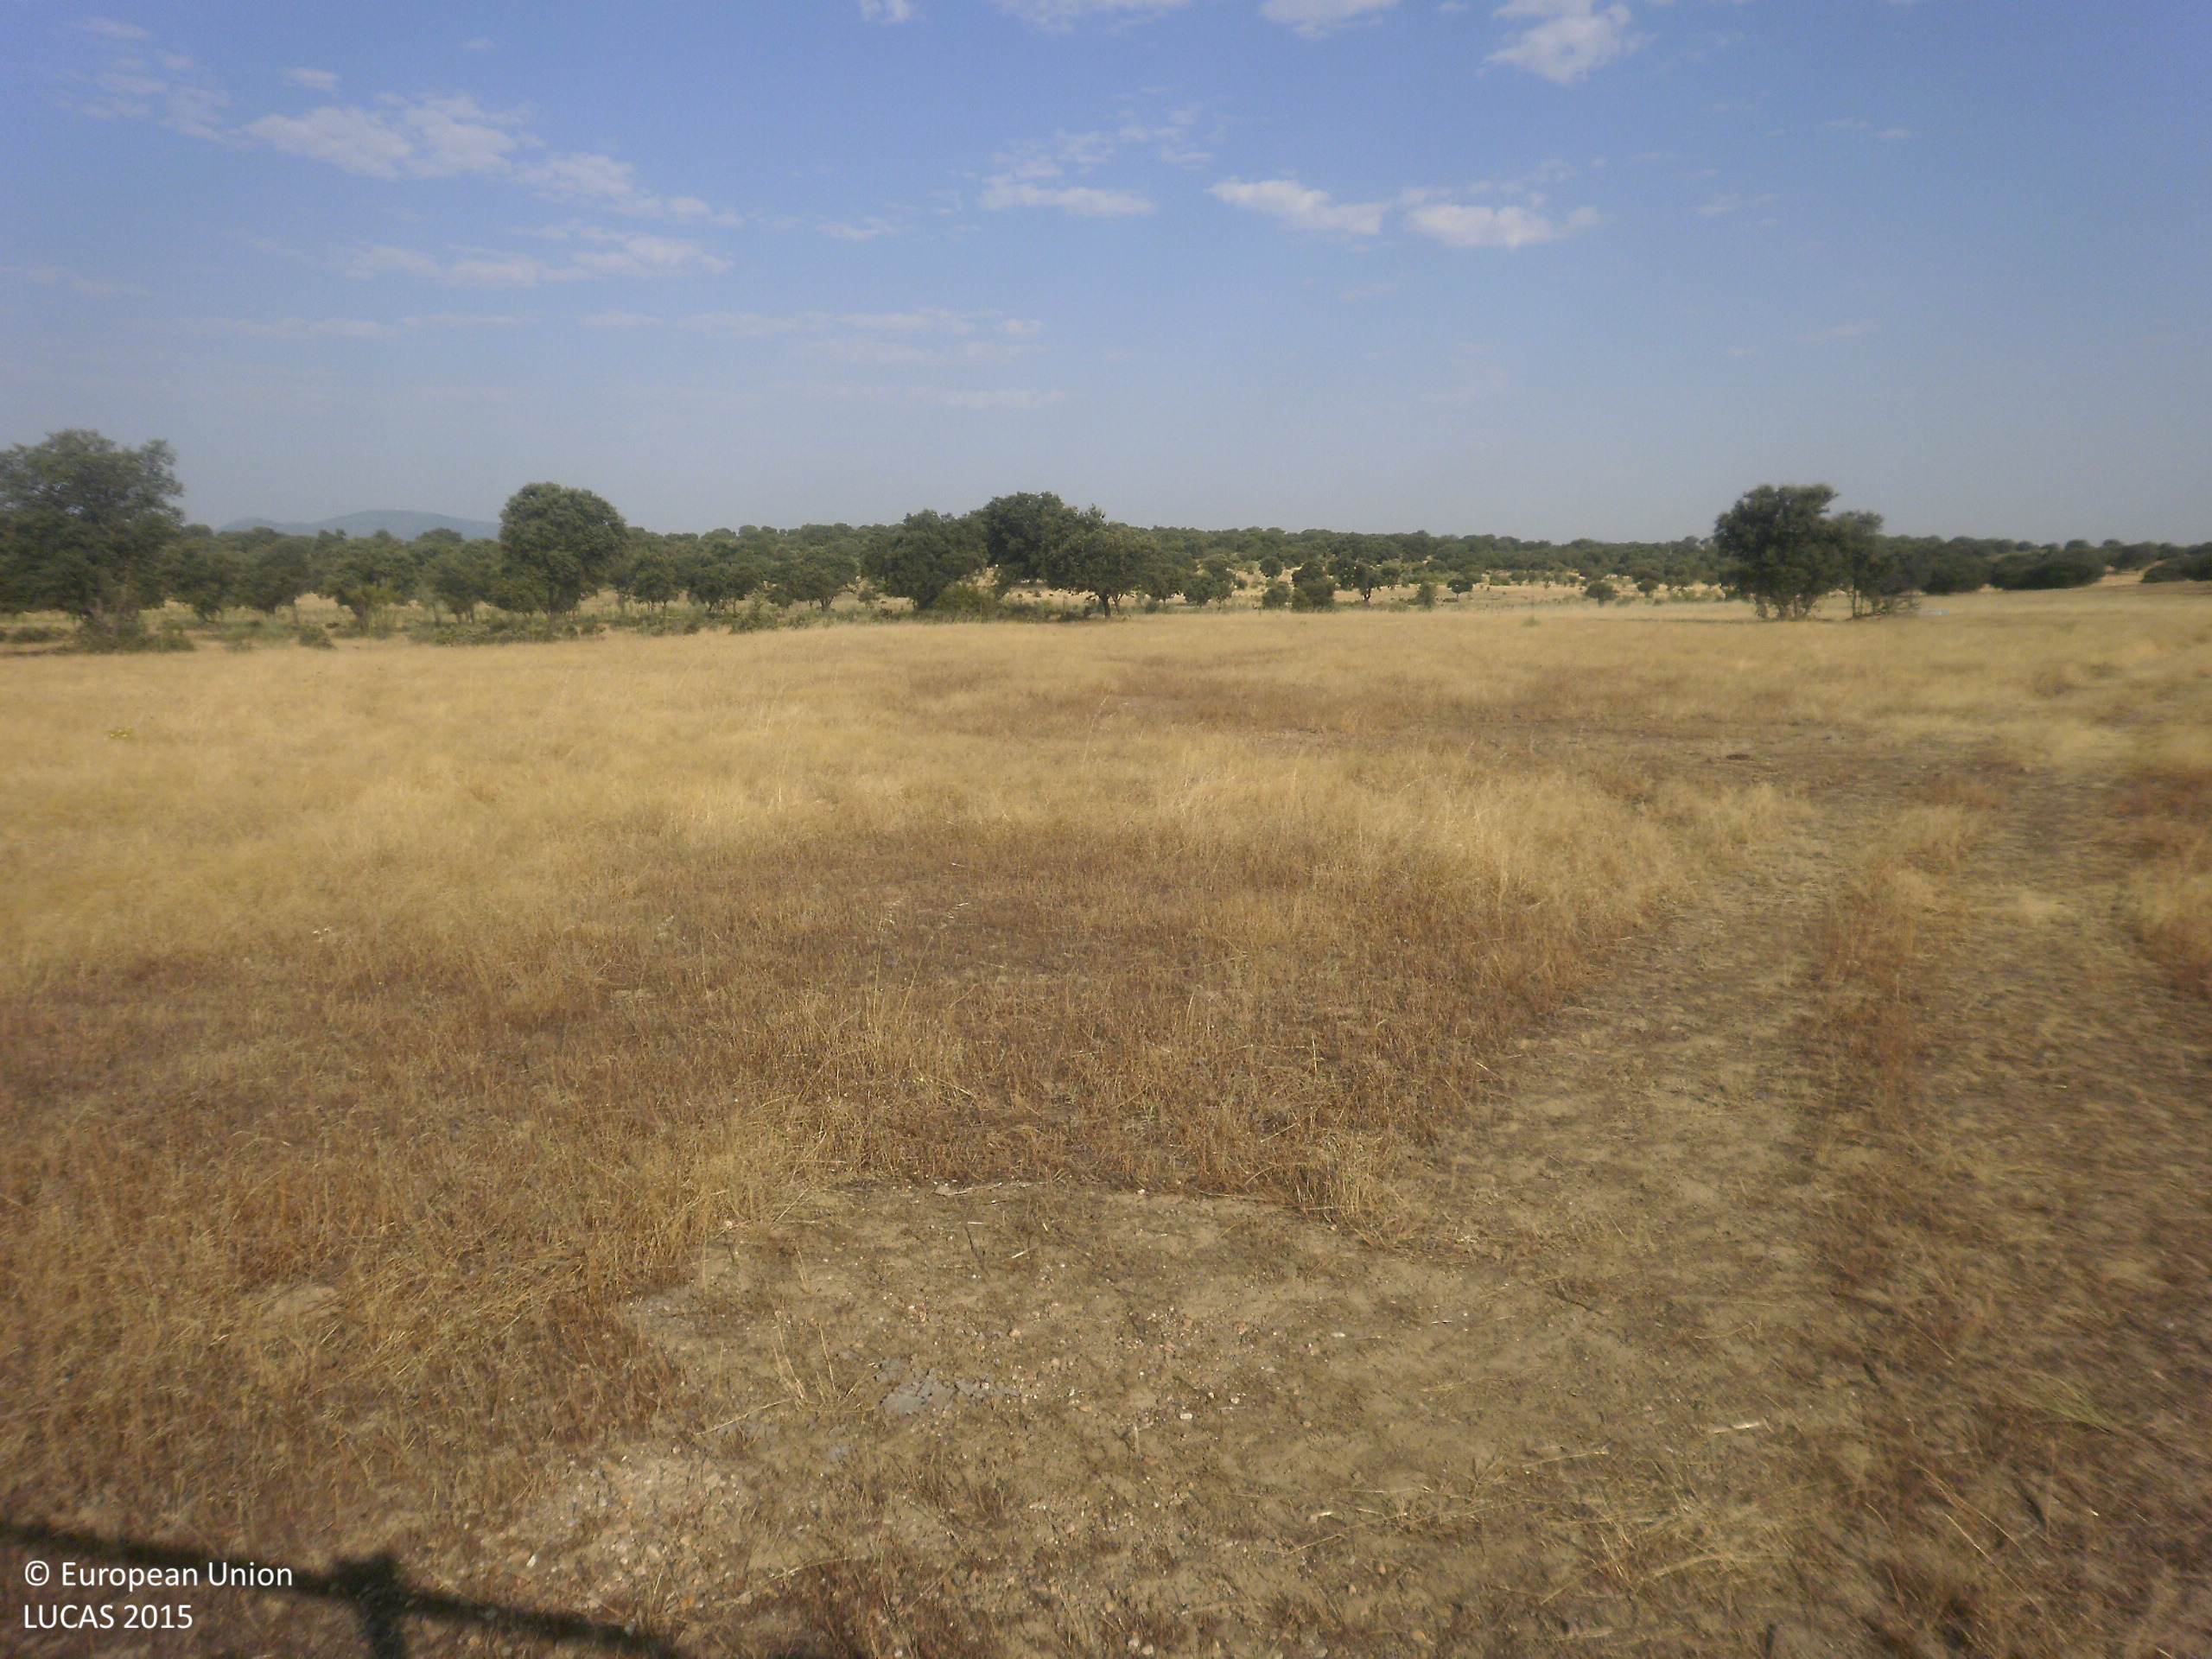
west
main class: Woodland
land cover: Broadleaved woodland
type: broadleaved evergreen forest
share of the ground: 10 - 25 %
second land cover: Grassland without tree/shrub cover
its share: 50 - 75 %
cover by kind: herbaceous plants 75 %, broadleaved forest trees 25 %
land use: Forestry
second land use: Agriculture (excluding fallow land and kitchen gardens)
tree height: > 5 m
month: June
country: ES
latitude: 39.2285
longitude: -5.8426
